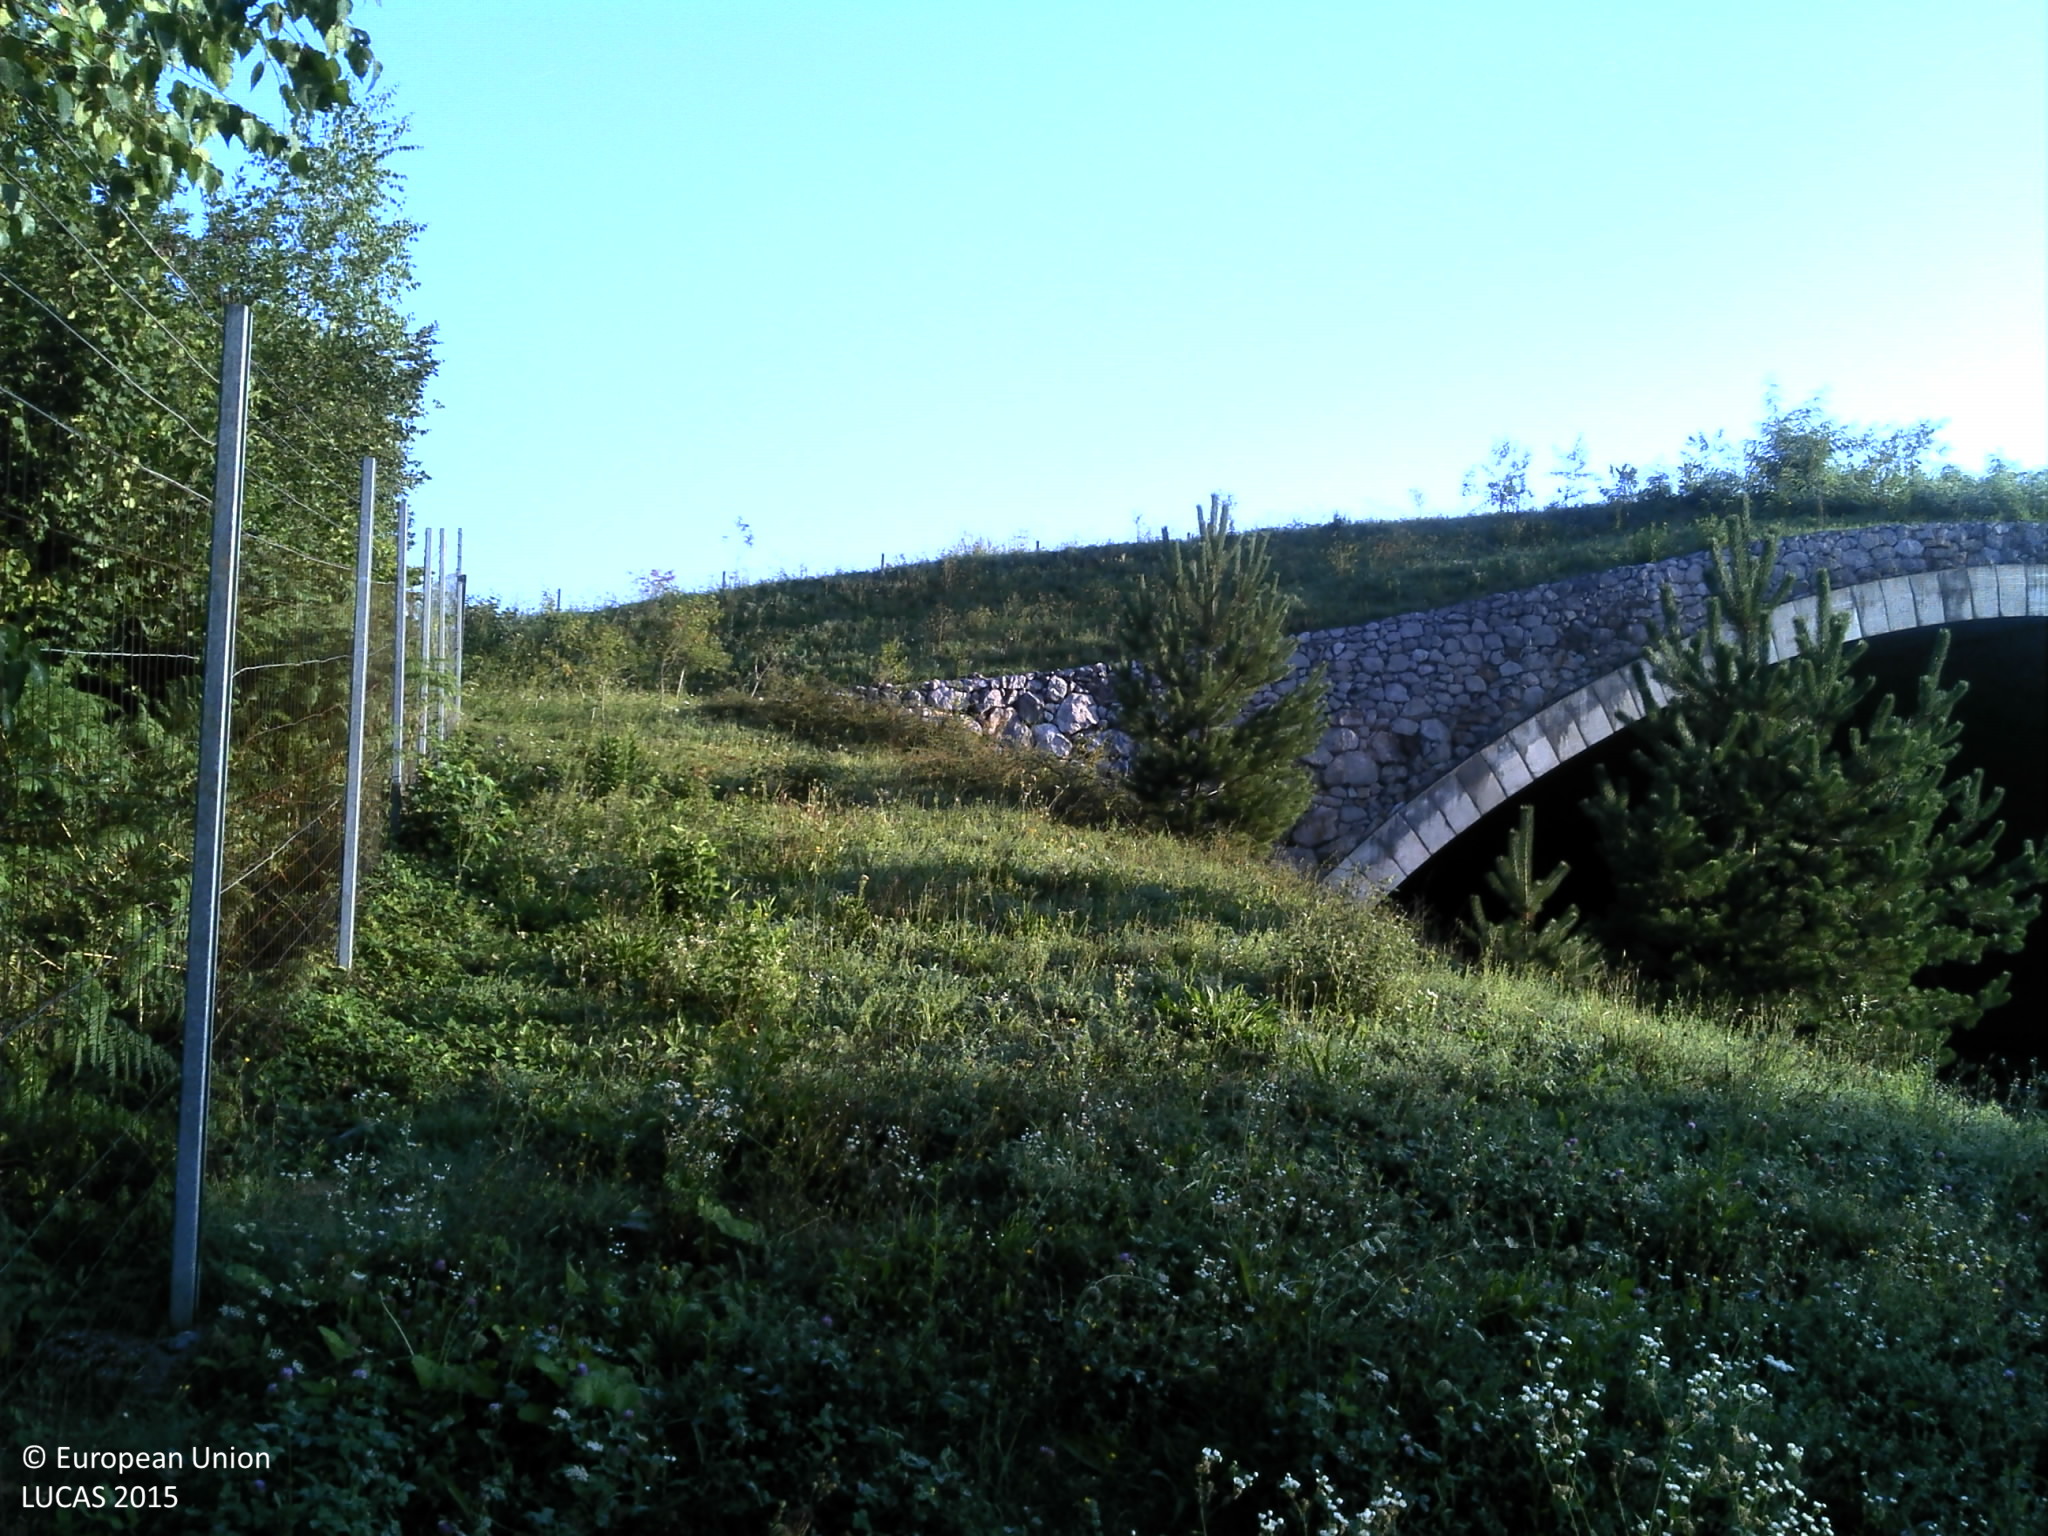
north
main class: Grassland
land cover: Spontaneously vegetated surfaces
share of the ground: > 75 %
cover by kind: herbaceous plants 100 %
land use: Road transport
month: September
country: HR
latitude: 45.3728
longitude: 15.2692
